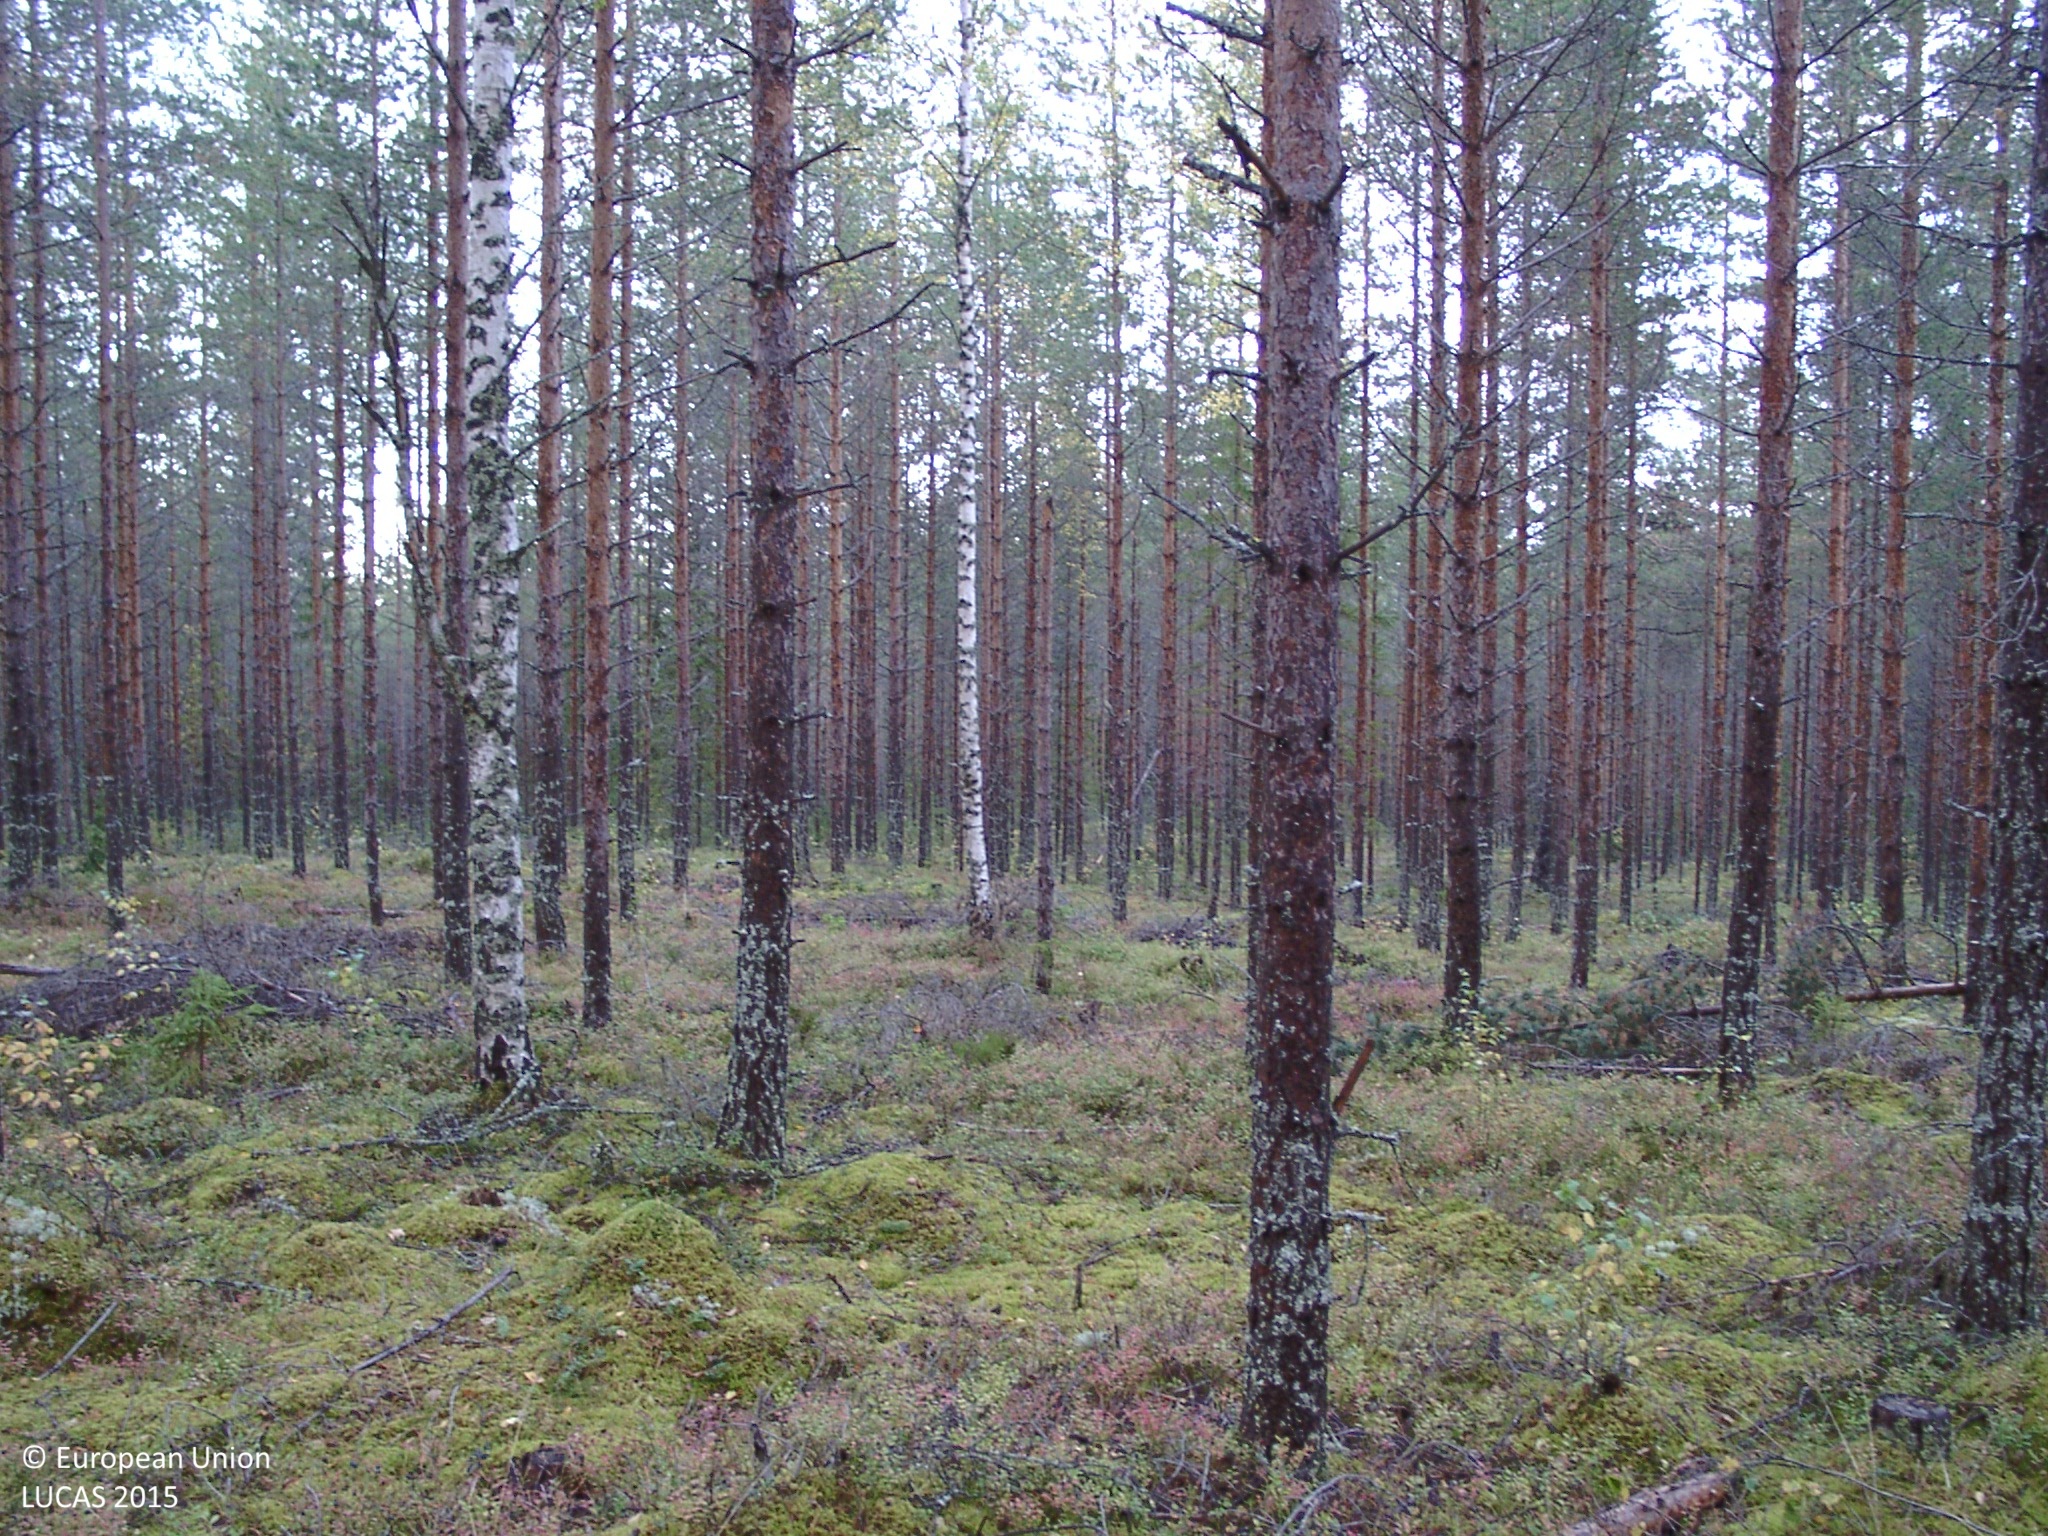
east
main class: Woodland
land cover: Pine dominated coniferous woodland
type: boreal forest
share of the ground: 50 - 75 %
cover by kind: coniferous forest trees 65 %, lichens and mosses 20 %, shrubs 15 %
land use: Forestry
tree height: > 5 m
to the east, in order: Pine dominated coniferous woodland; Tracks; Pine dominated coniferous woodland; Tracks; Pine dominated coniferous woodland
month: September
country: FI
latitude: 62.7380
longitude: 25.5502
